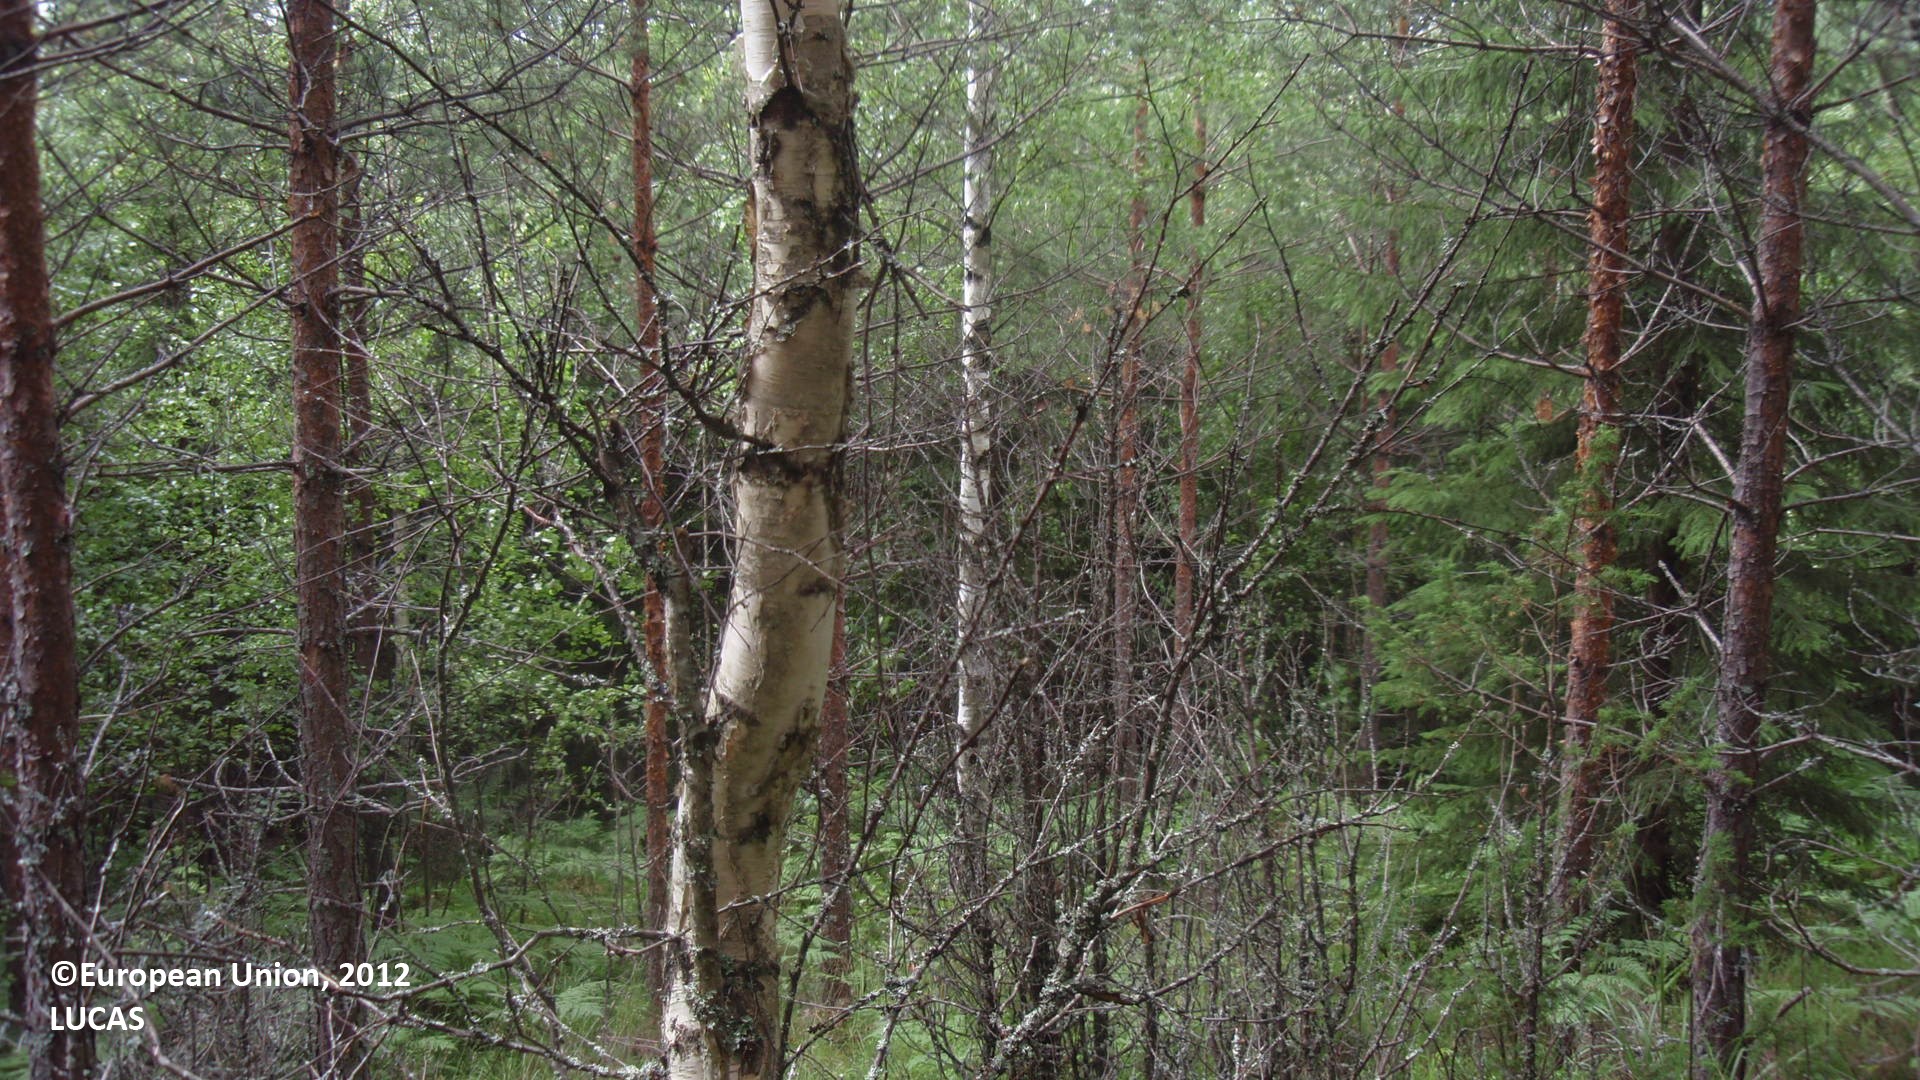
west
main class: Woodland
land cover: Pine dominated mixed woodland
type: boreal forest
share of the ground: 50 - 75 %
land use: Forestry
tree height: > 5 m
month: July
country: FI
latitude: 61.4487
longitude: 28.4994
